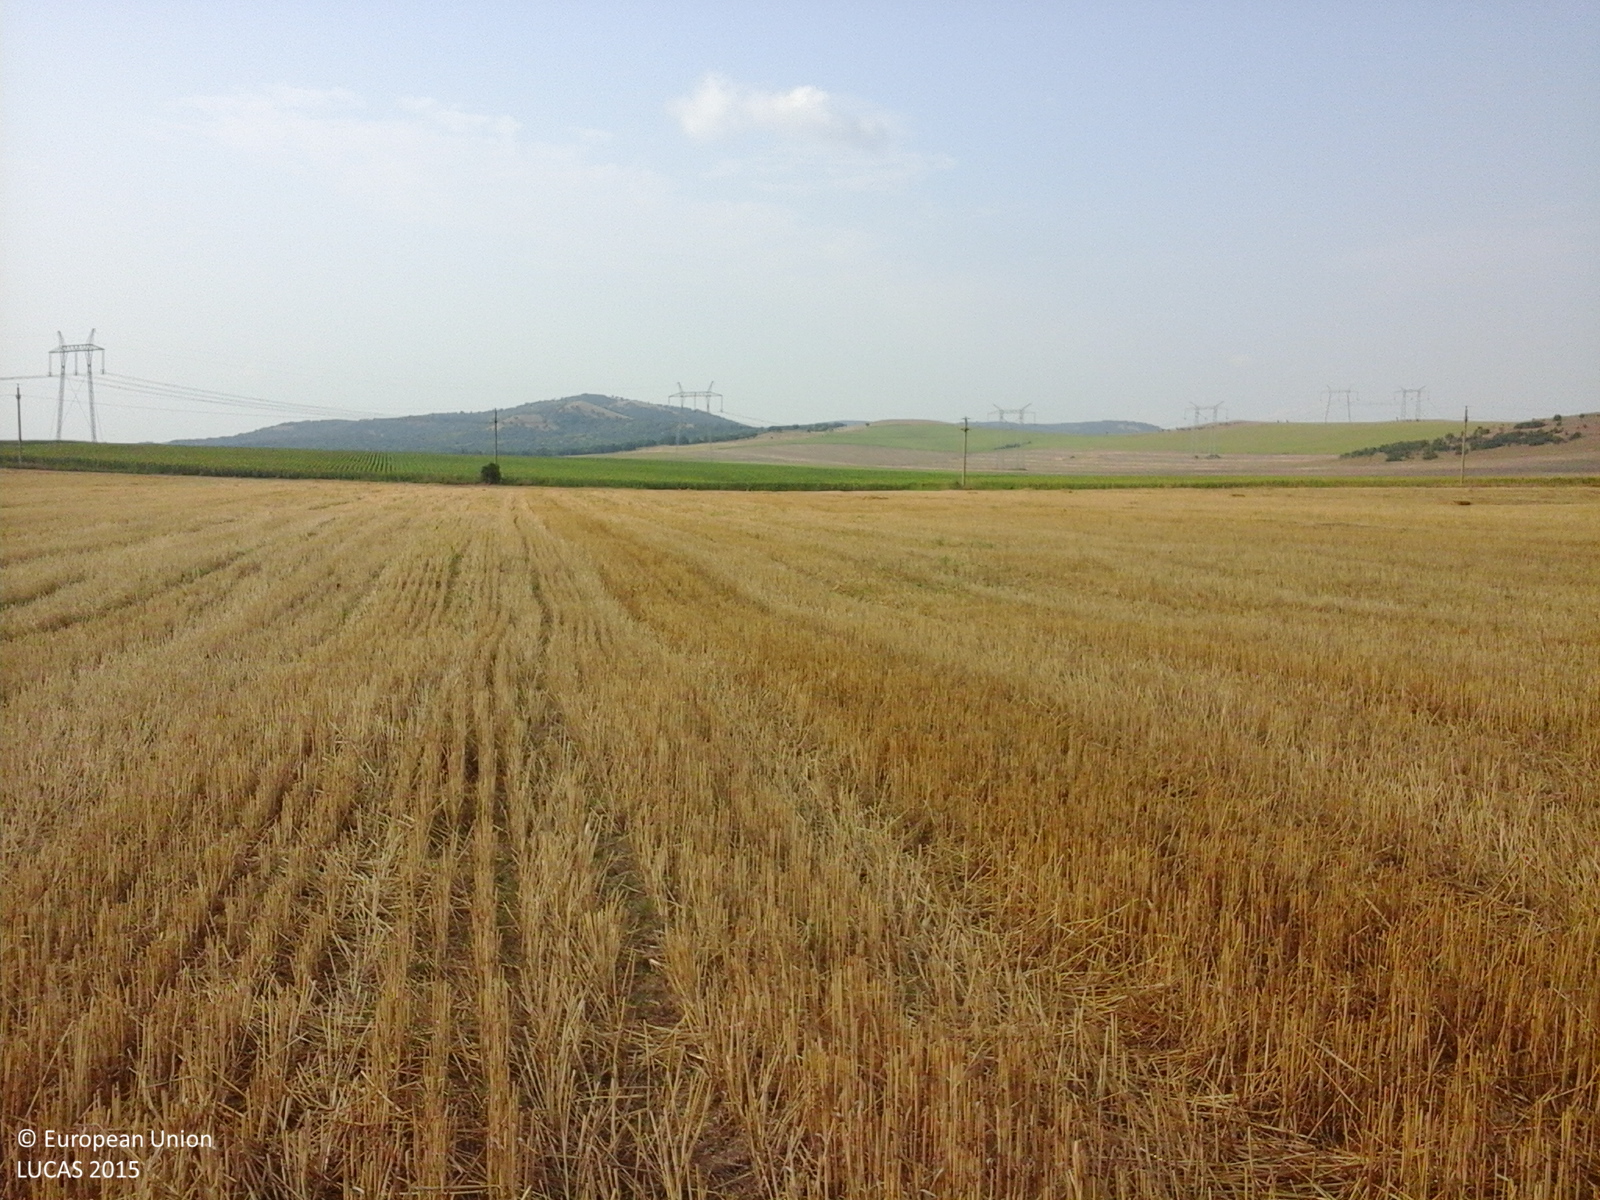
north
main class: Cropland
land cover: Common wheat
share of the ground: > 75 %
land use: Agriculture (excluding fallow land and kitchen gardens)
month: July
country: RO
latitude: 45.0642
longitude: 28.4279
